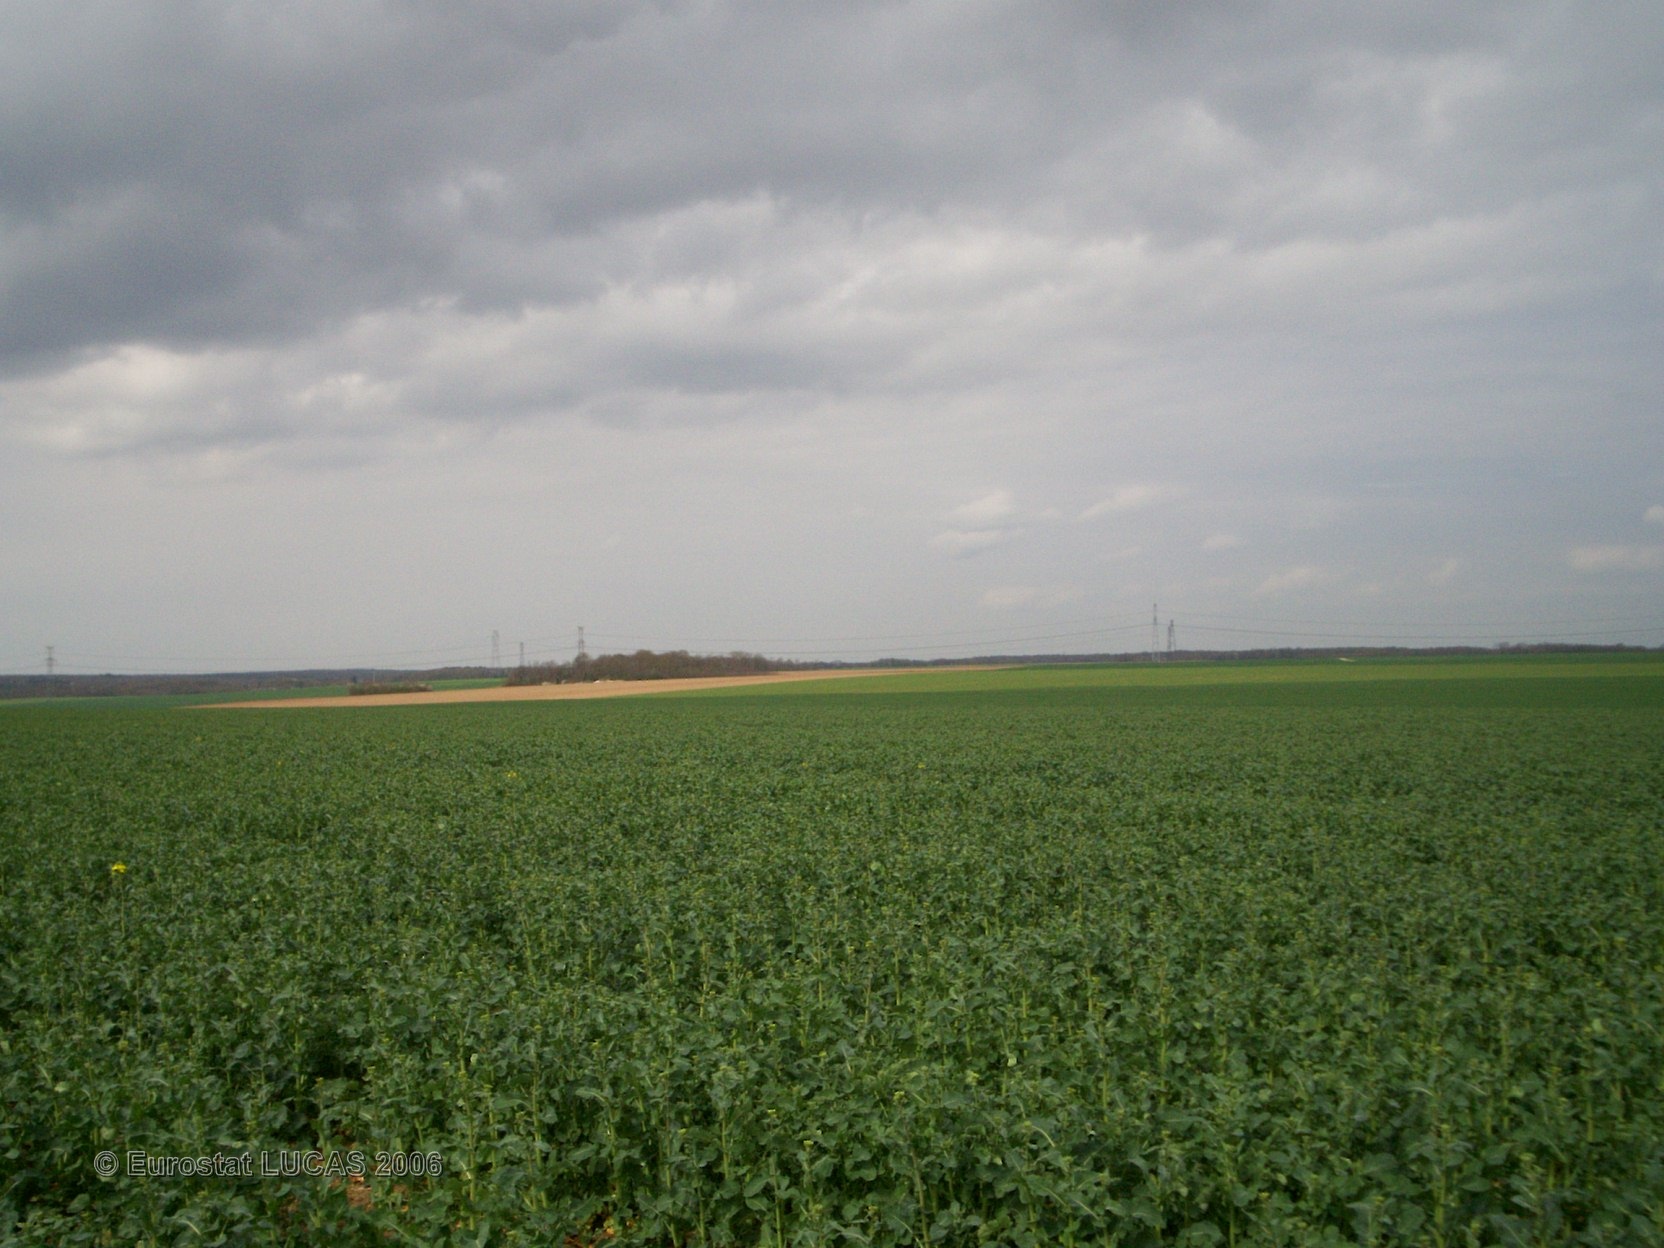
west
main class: Cropland
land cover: Rape and turnip rape
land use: Agriculture (excluding fallow land and kitchen gardens)
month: April
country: FR
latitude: 48.2632
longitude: 2.8655
